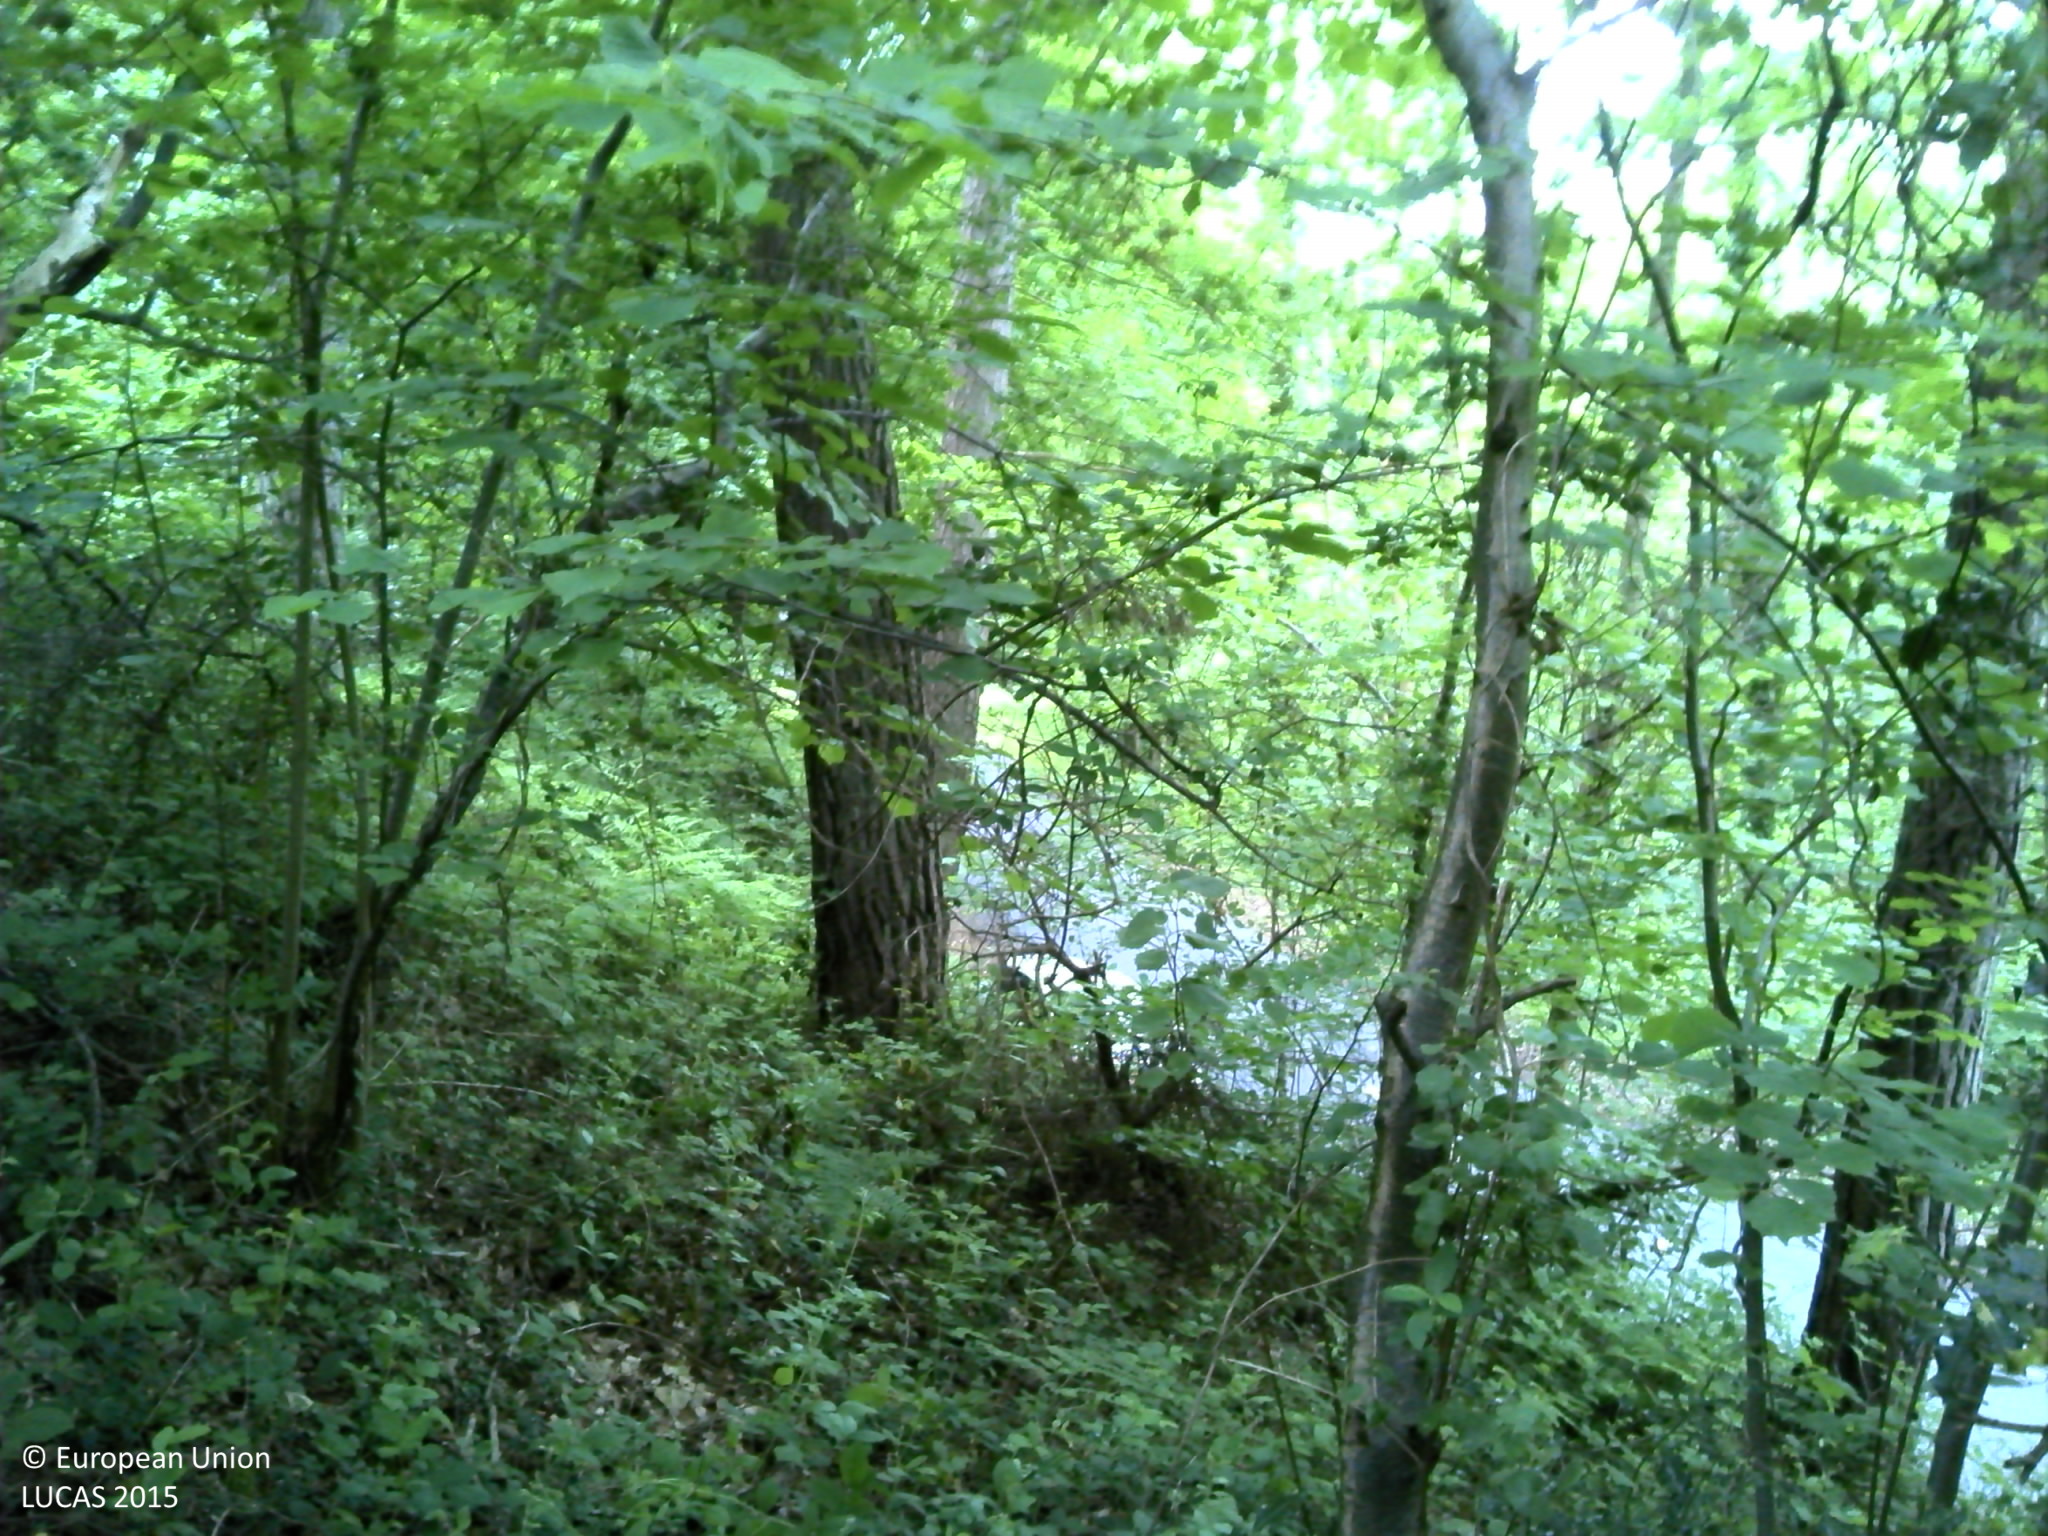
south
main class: Woodland
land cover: Broadleaved woodland
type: acidophilous oak and oak-birch forest
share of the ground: > 75 %
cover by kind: broadleaved forest trees 85 %, herbaceous plants 15 %
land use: Forestry
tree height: > 5 m
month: June
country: FR
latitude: 49.5746
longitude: 1.0025
